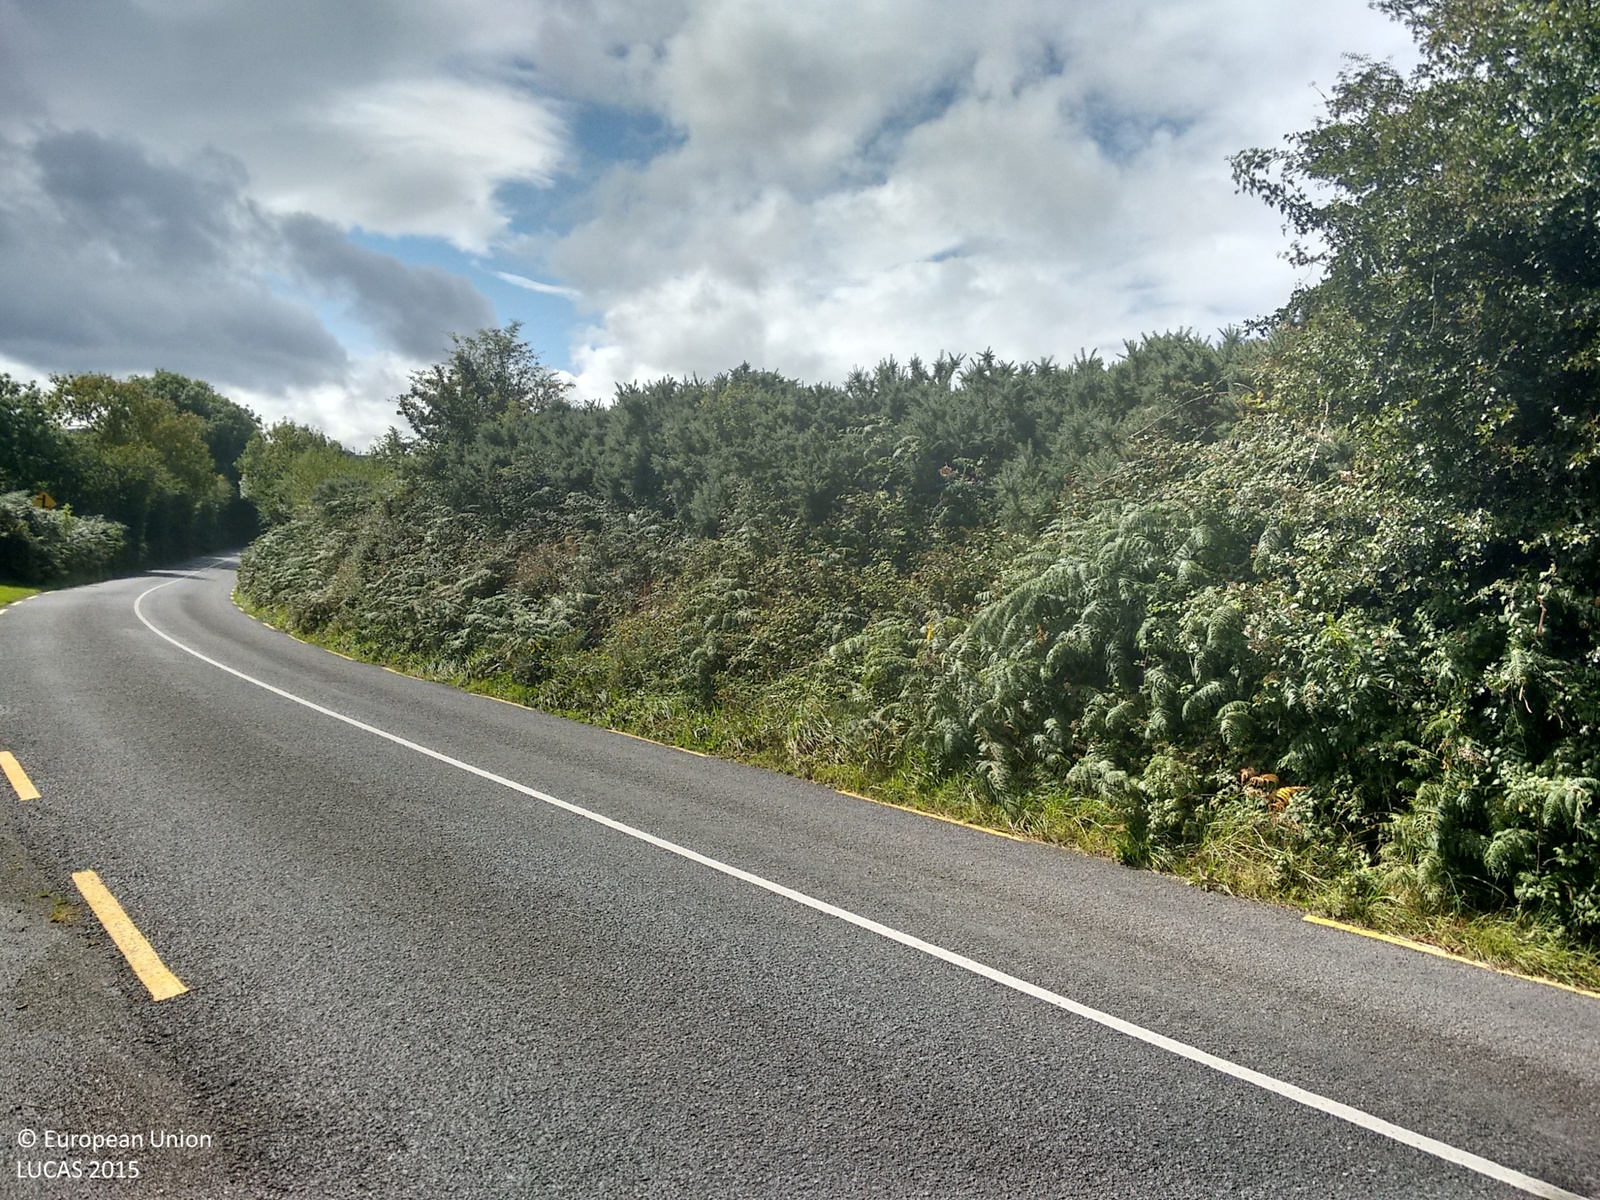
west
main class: Grassland
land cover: Grassland without tree/shrub cover
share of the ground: > 75 %
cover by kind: herbaceous plants 70 %, consolidated bare surface 25 %, shrubs 5 %
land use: Residential
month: August
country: IE
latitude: 52.0955
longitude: -9.7904
